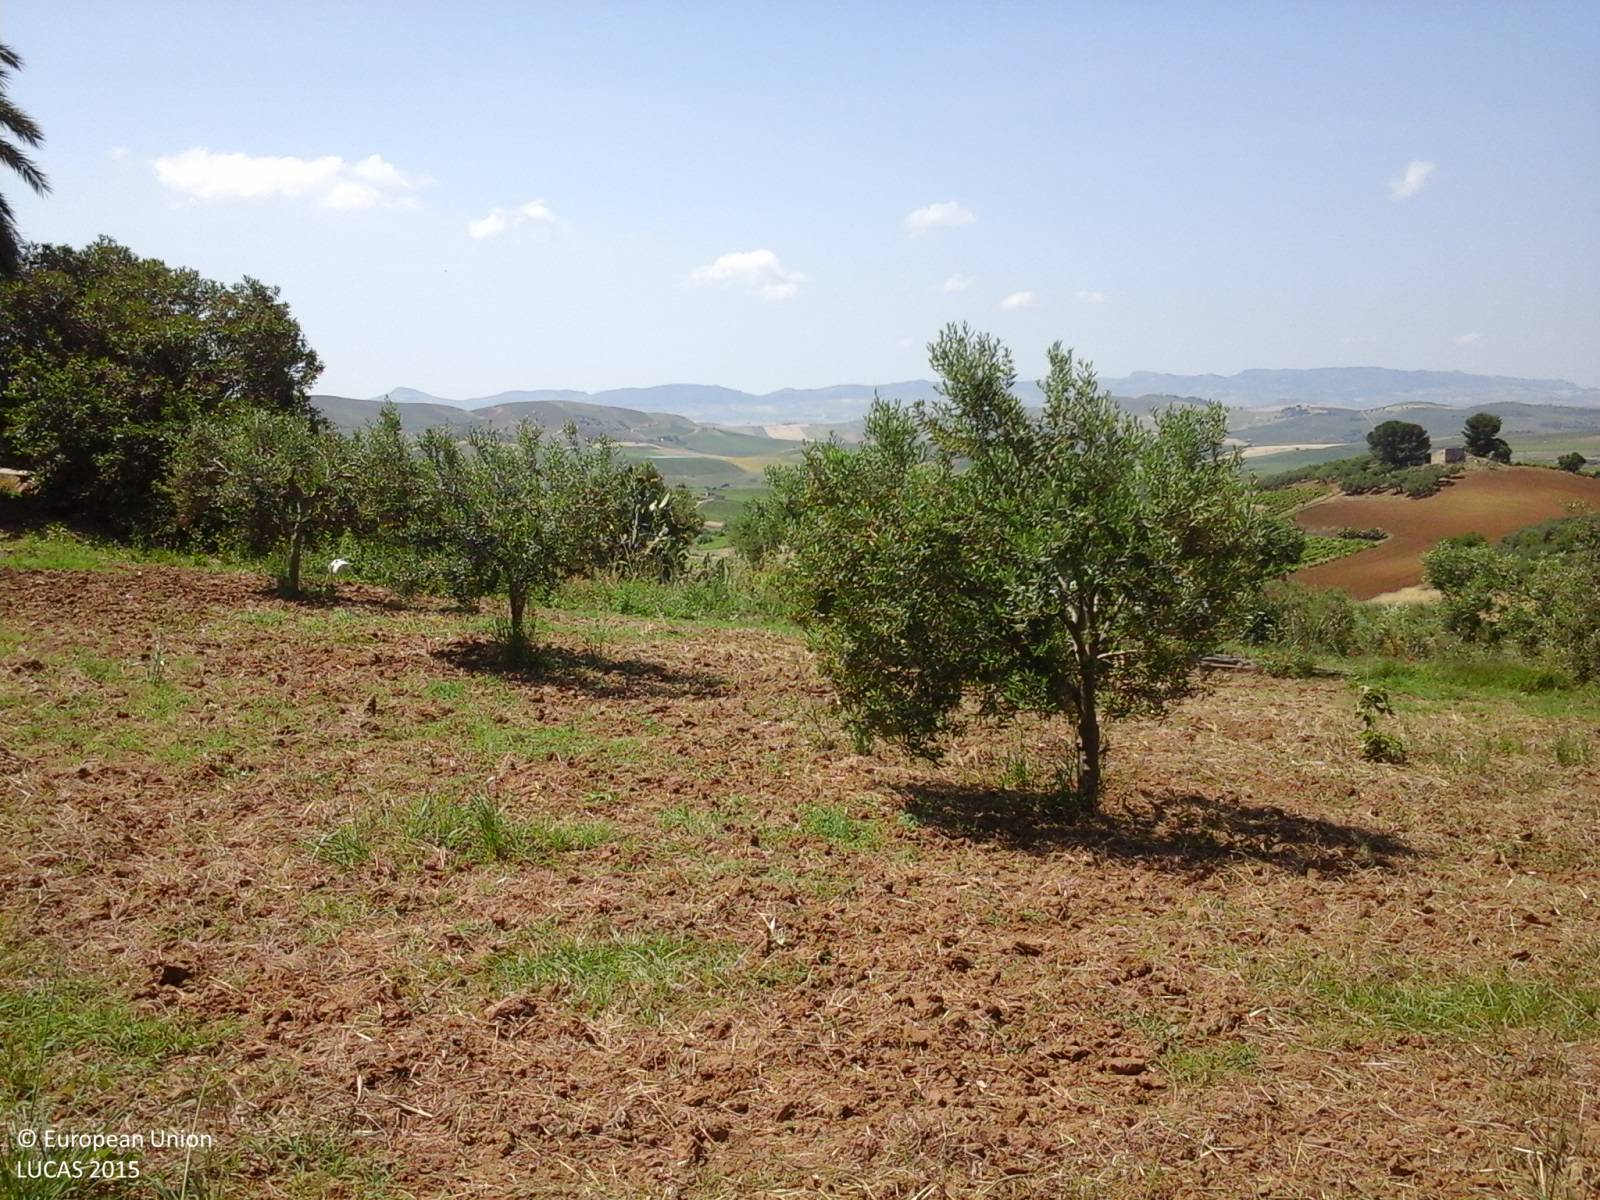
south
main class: Grassland
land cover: Spontaneously vegetated surfaces
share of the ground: > 75 %
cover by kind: herbaceous plants 100 %
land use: Agriculture (excluding fallow land and kitchen gardens)
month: June
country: IT
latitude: 37.9359
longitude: 13.0161
